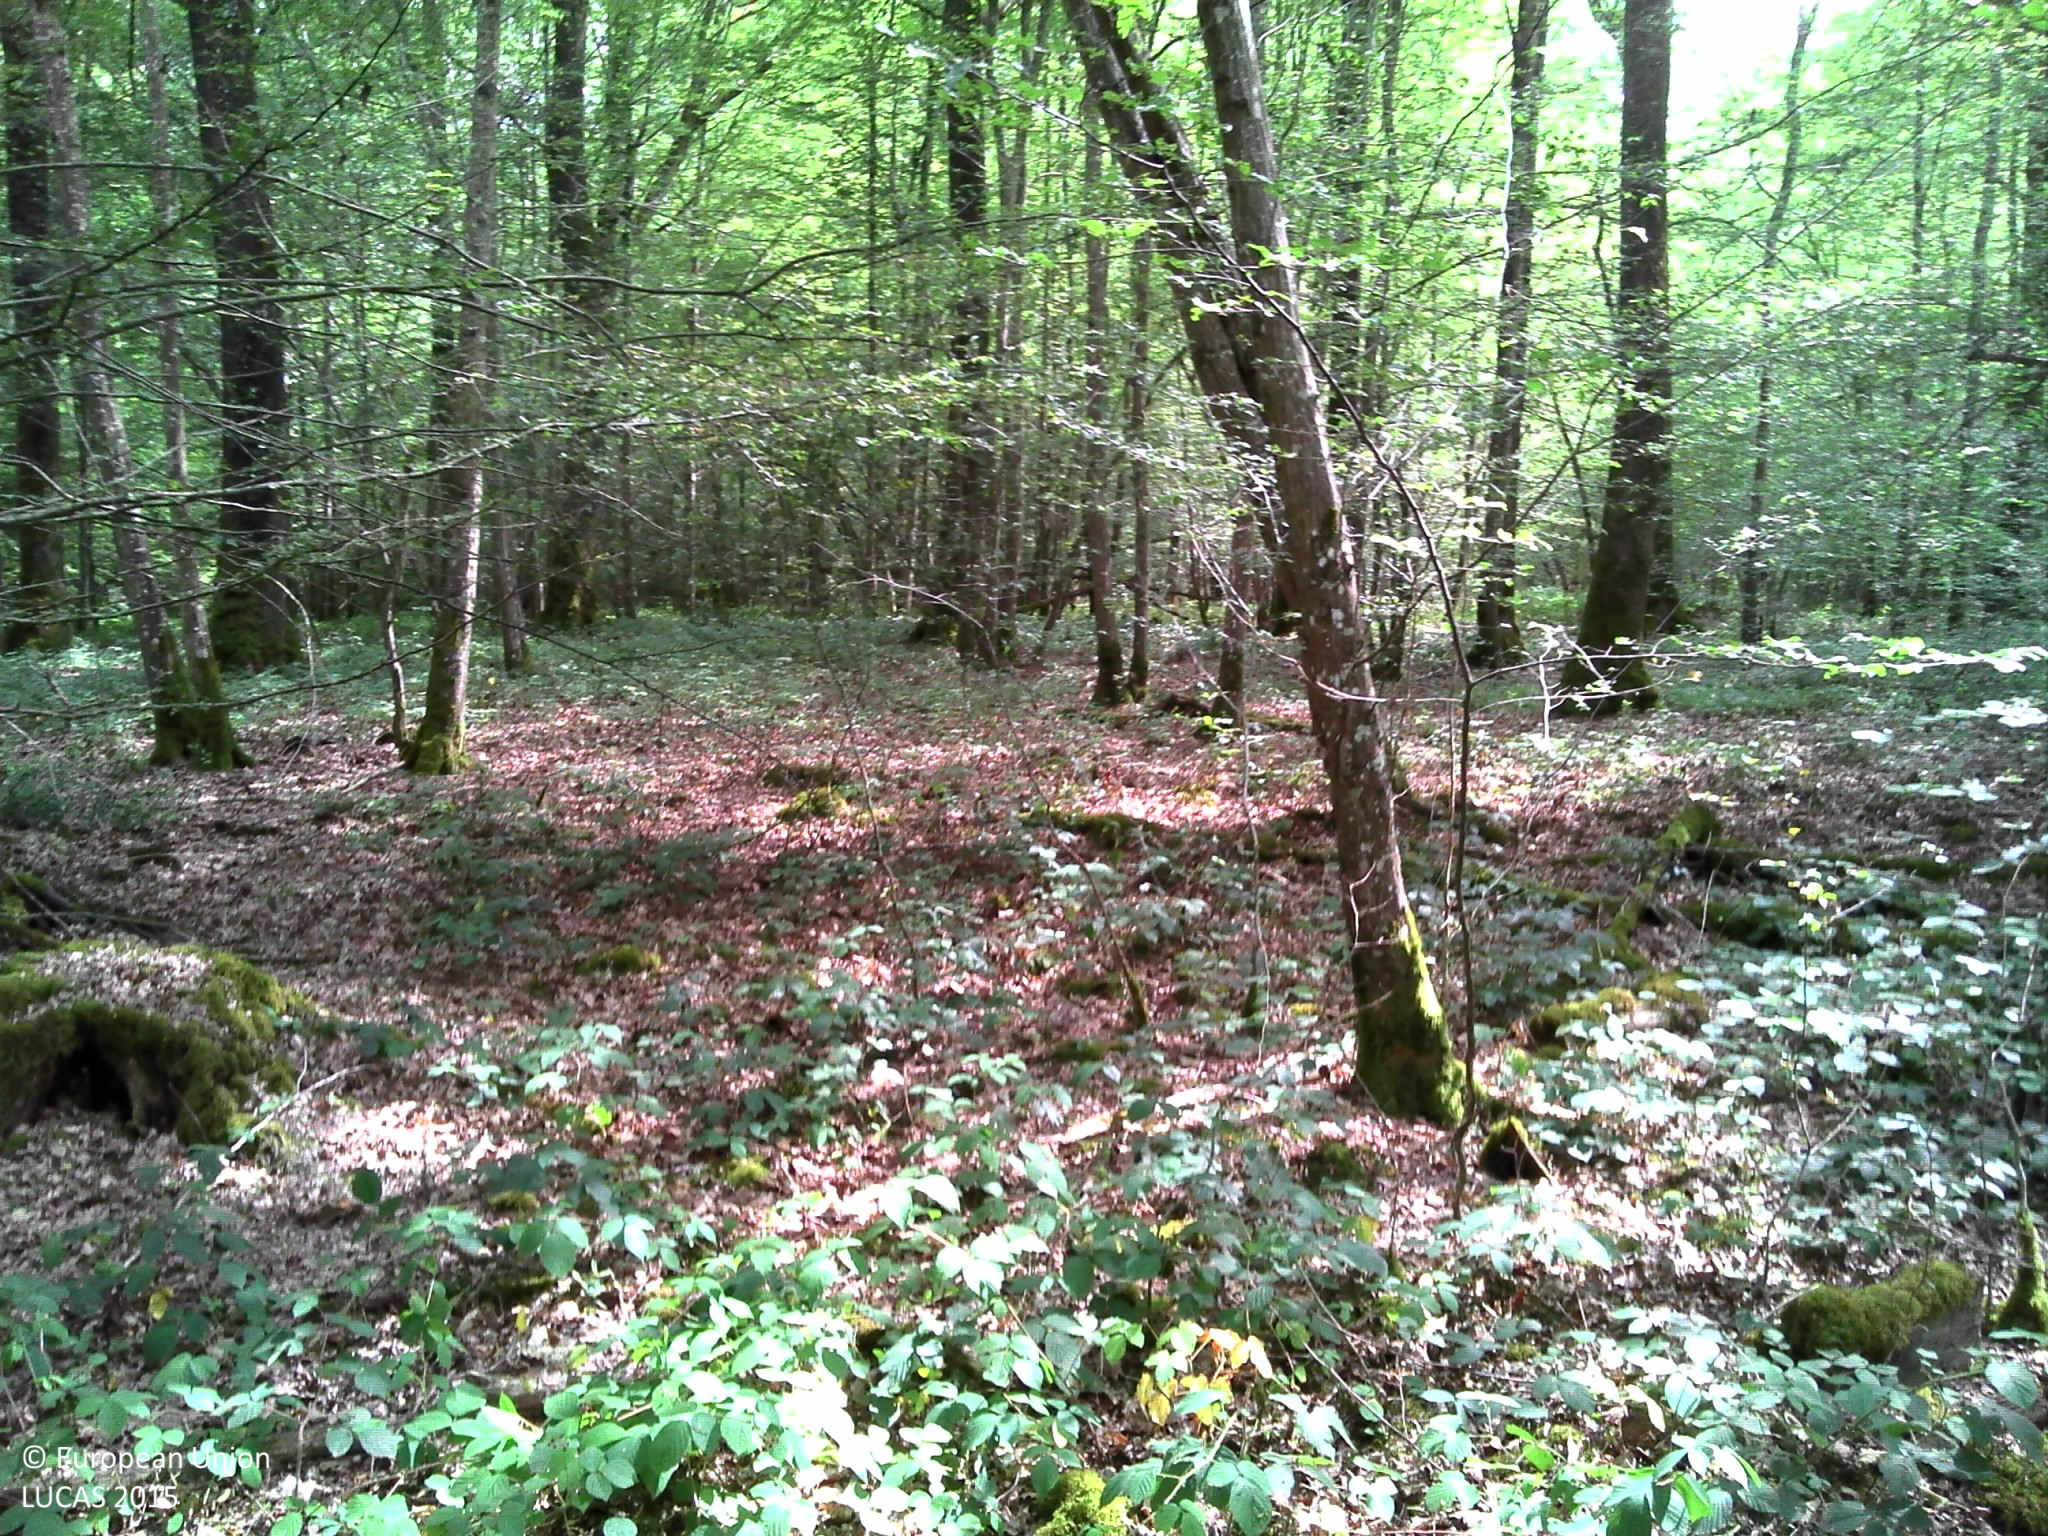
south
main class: Woodland
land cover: Broadleaved woodland
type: mesophytic deciduous forest
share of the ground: > 75 %
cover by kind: broadleaved forest trees 90 %, herbaceous plants 5 %, lichens and mosses 5 %
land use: Forestry
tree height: > 5 m
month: July
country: FR
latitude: 48.0766
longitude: 3.0536
